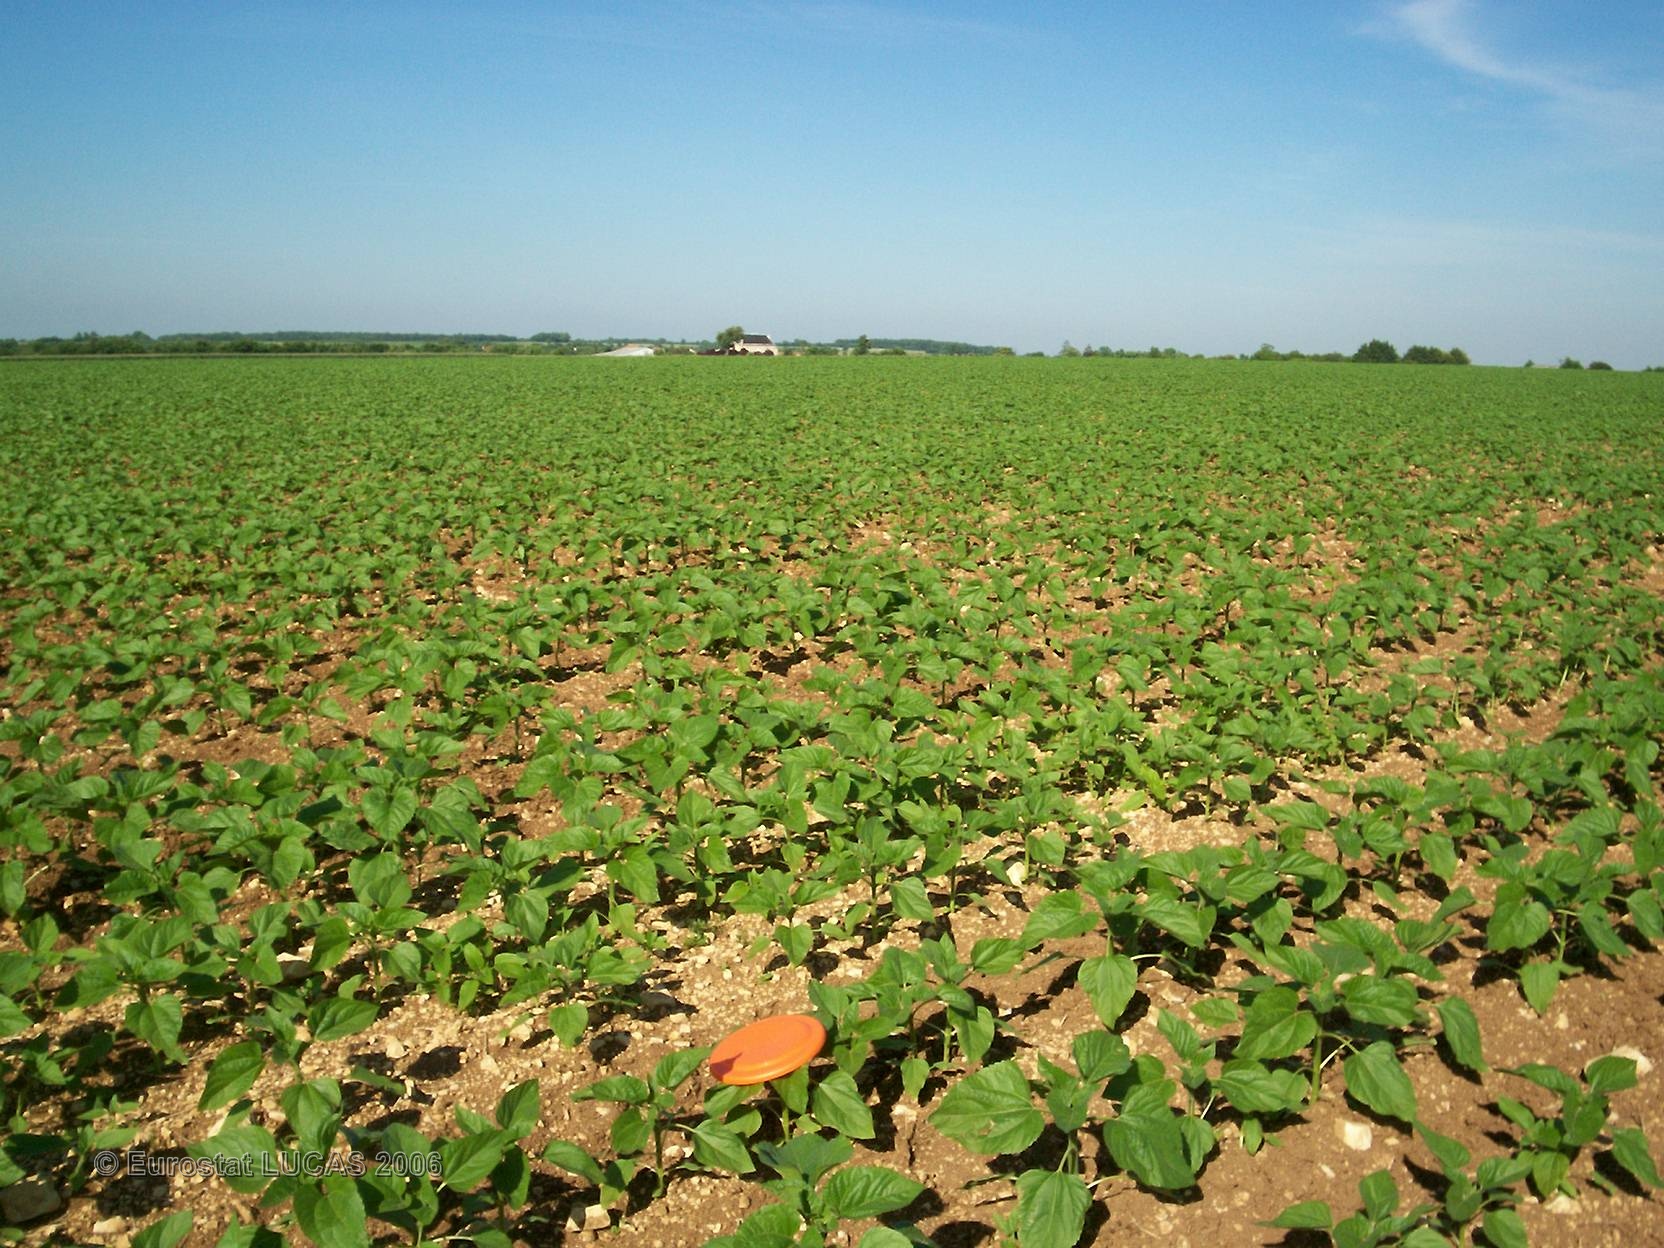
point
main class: Cropland
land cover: Sunflower
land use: Agriculture (excluding fallow land and kitchen gardens)
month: April
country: FR
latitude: 46.0858
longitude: -0.6958
